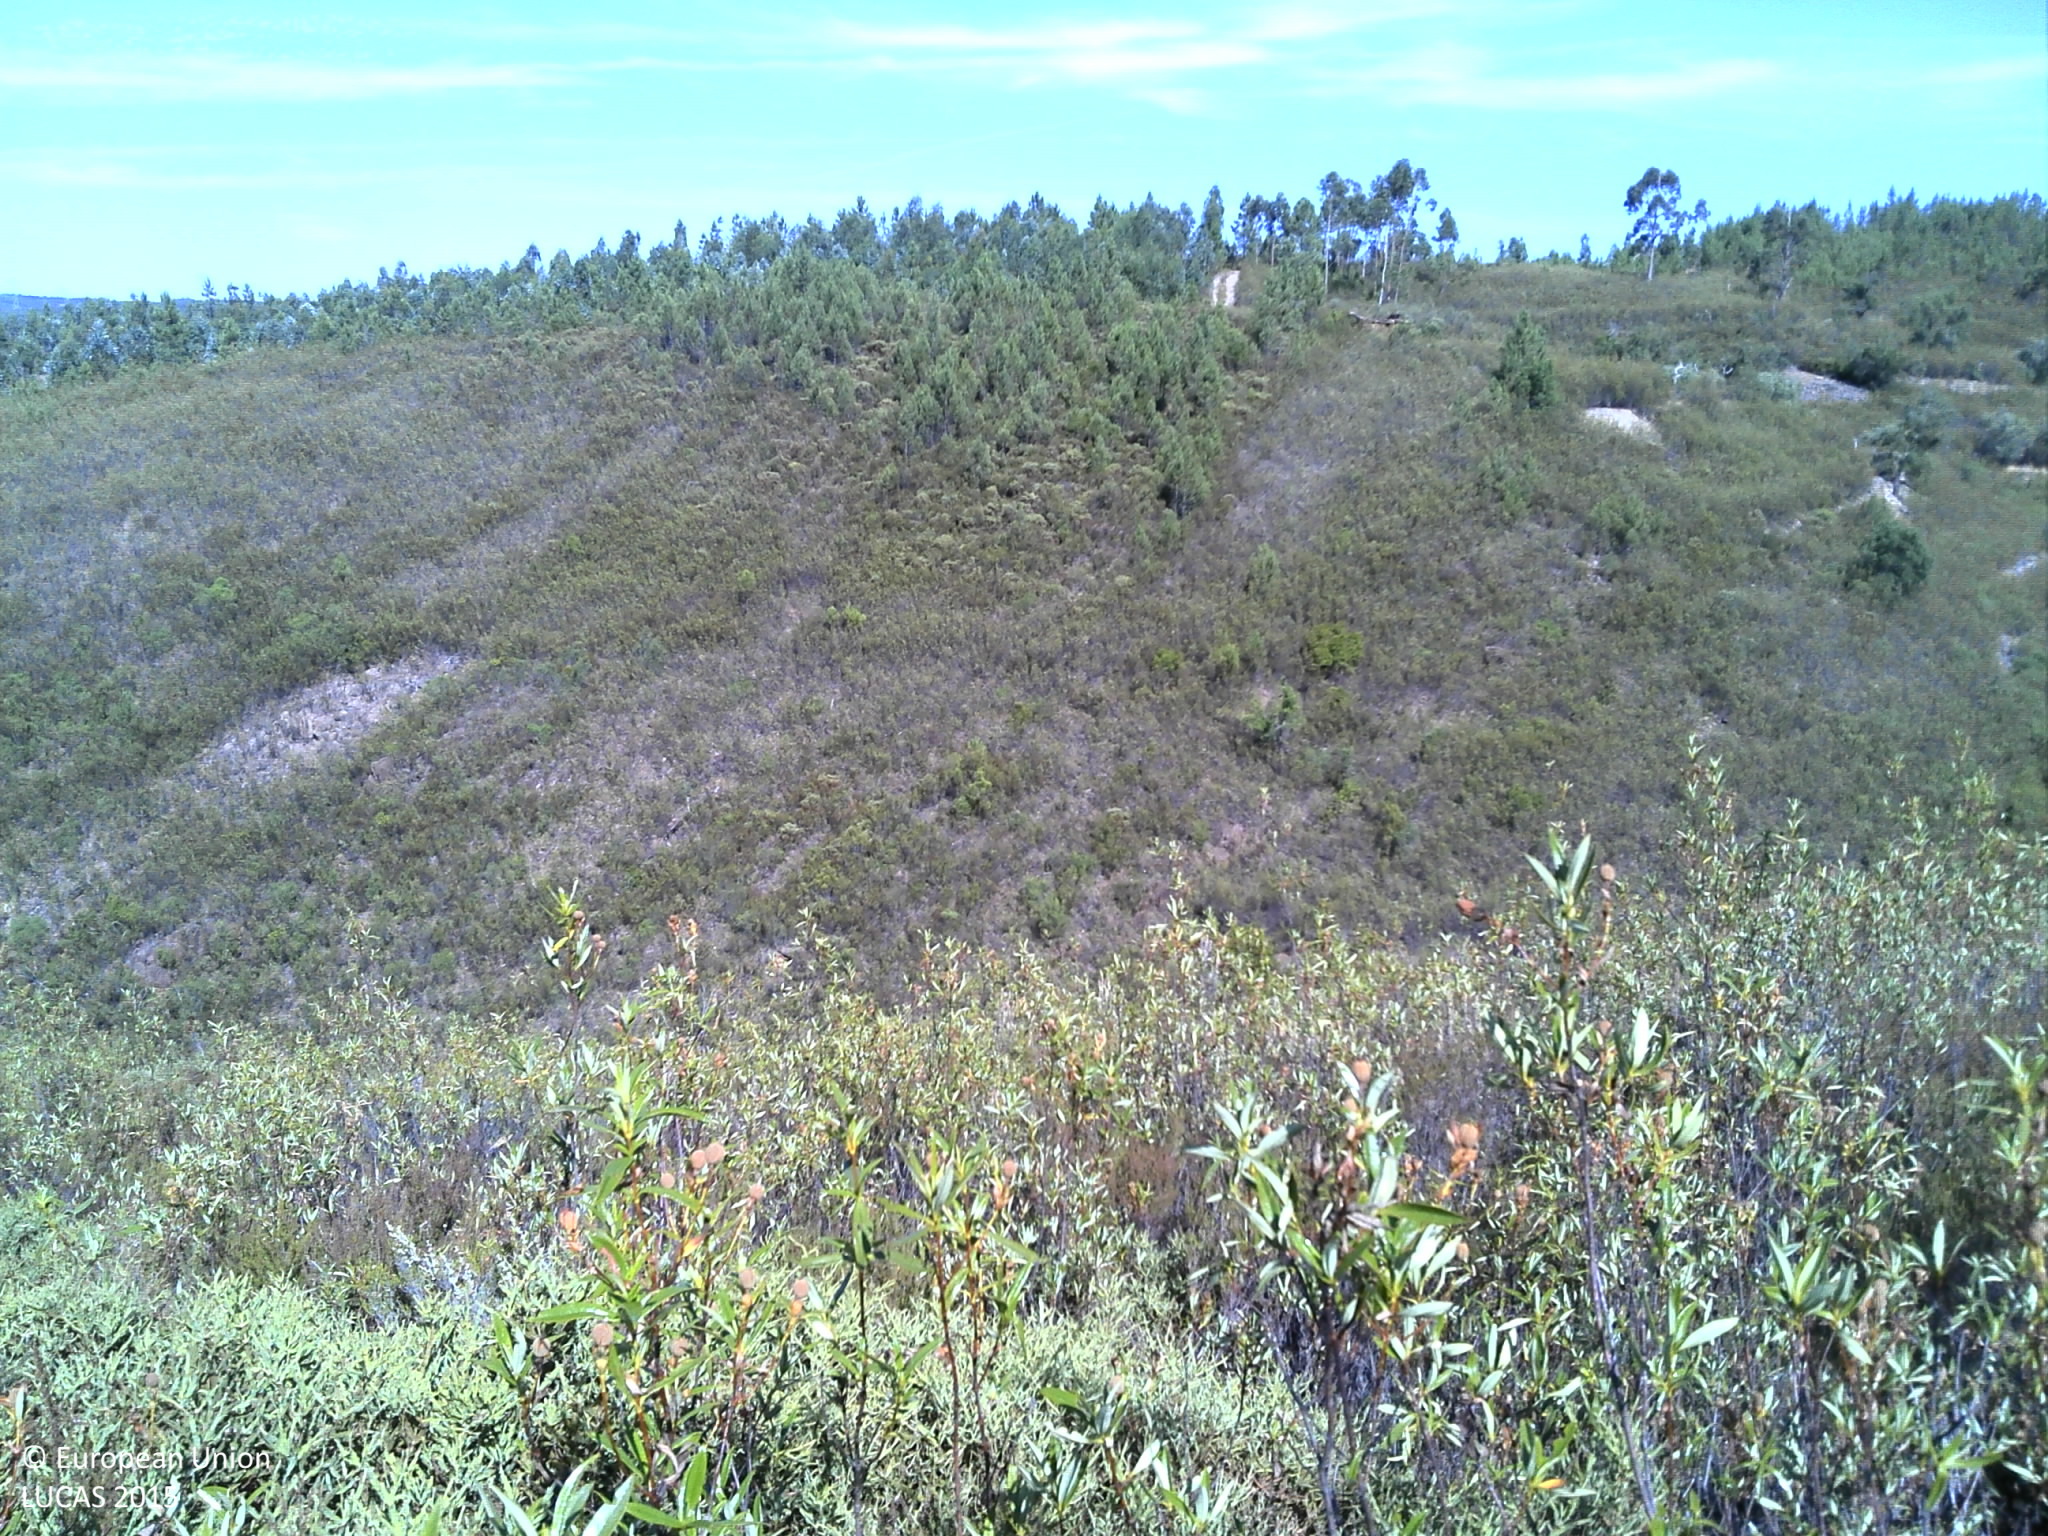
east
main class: Shrubland
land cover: Shrubland without tree cover
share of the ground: > 75 %
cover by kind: shrubs 100 %
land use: Semi-natural and natural areas not in use
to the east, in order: Shrubland without tree cover; Rivers and streams; Shrubland without tree cover; Shrubland with sparse tree cover; Pine dominated coniferous woodland; Tracks; Broadleaved woodland
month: July
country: PT
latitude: 39.7272
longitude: -7.7320
